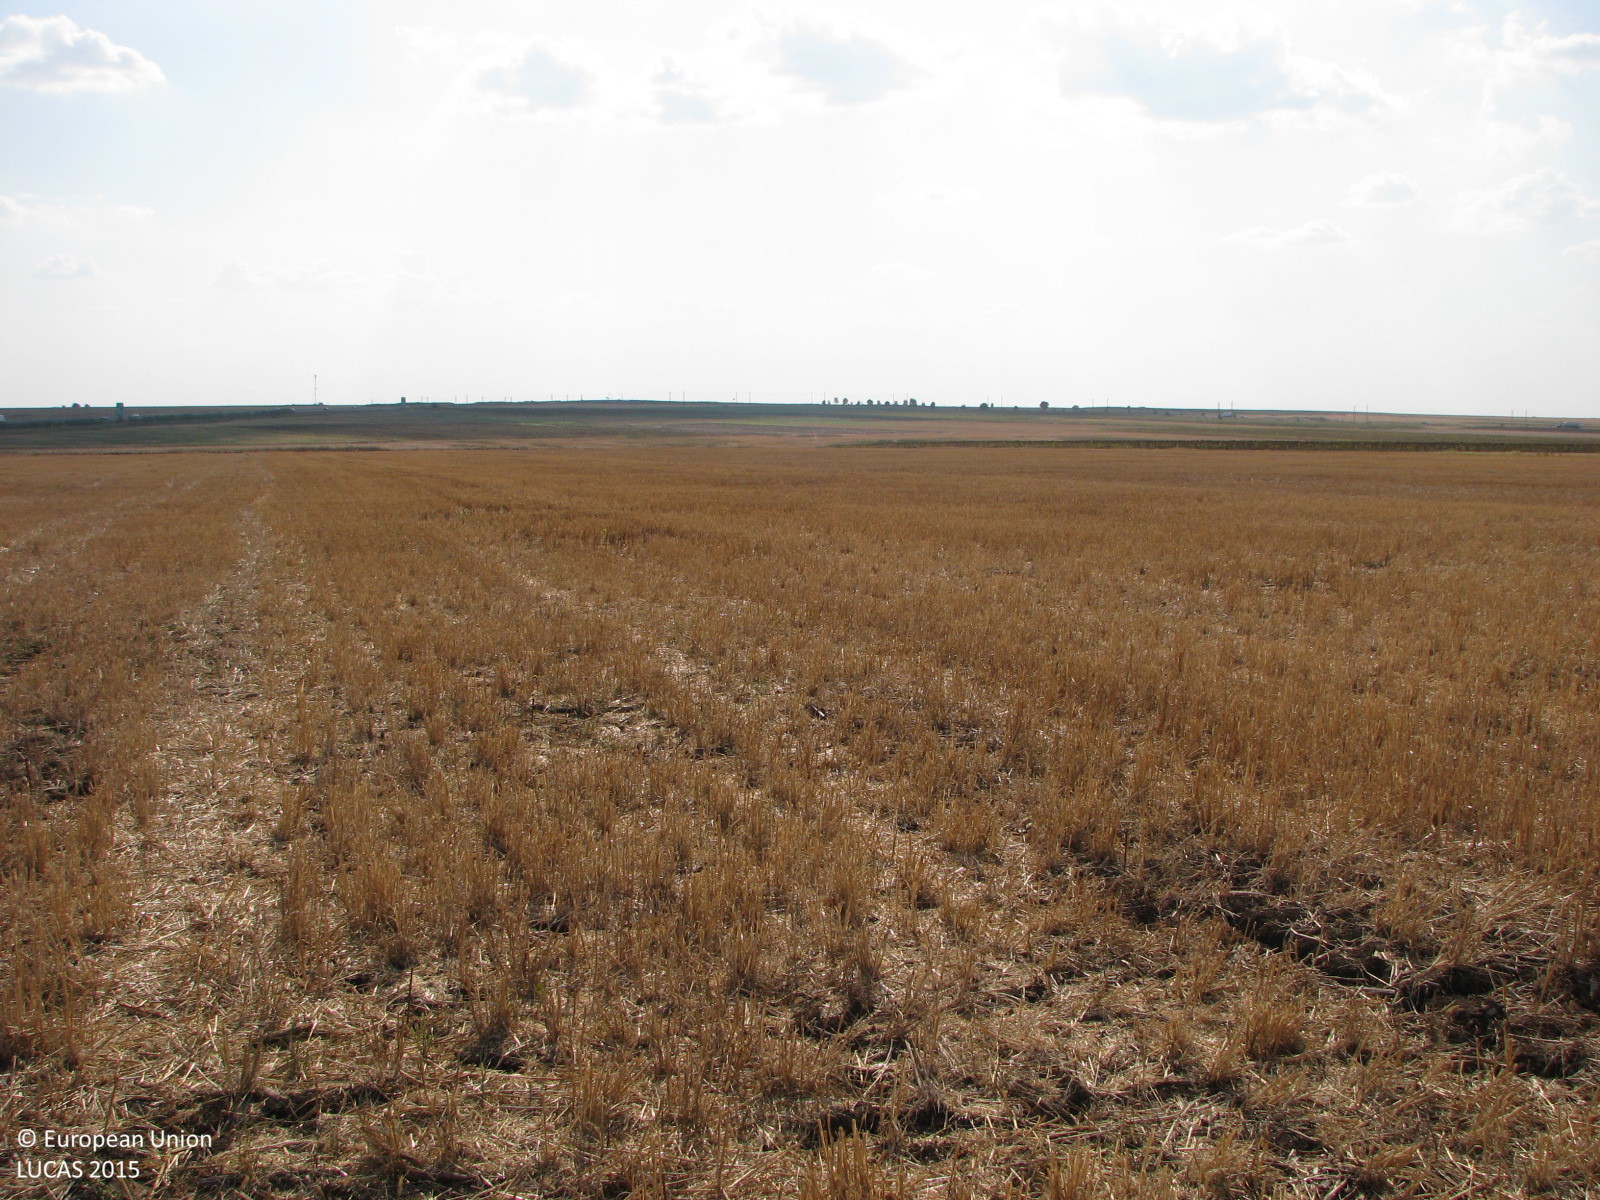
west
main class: Cropland
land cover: Common wheat
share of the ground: 25 - 50 %
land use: Agriculture (excluding fallow land and kitchen gardens)
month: August
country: BG
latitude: 42.5608
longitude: 26.5998
